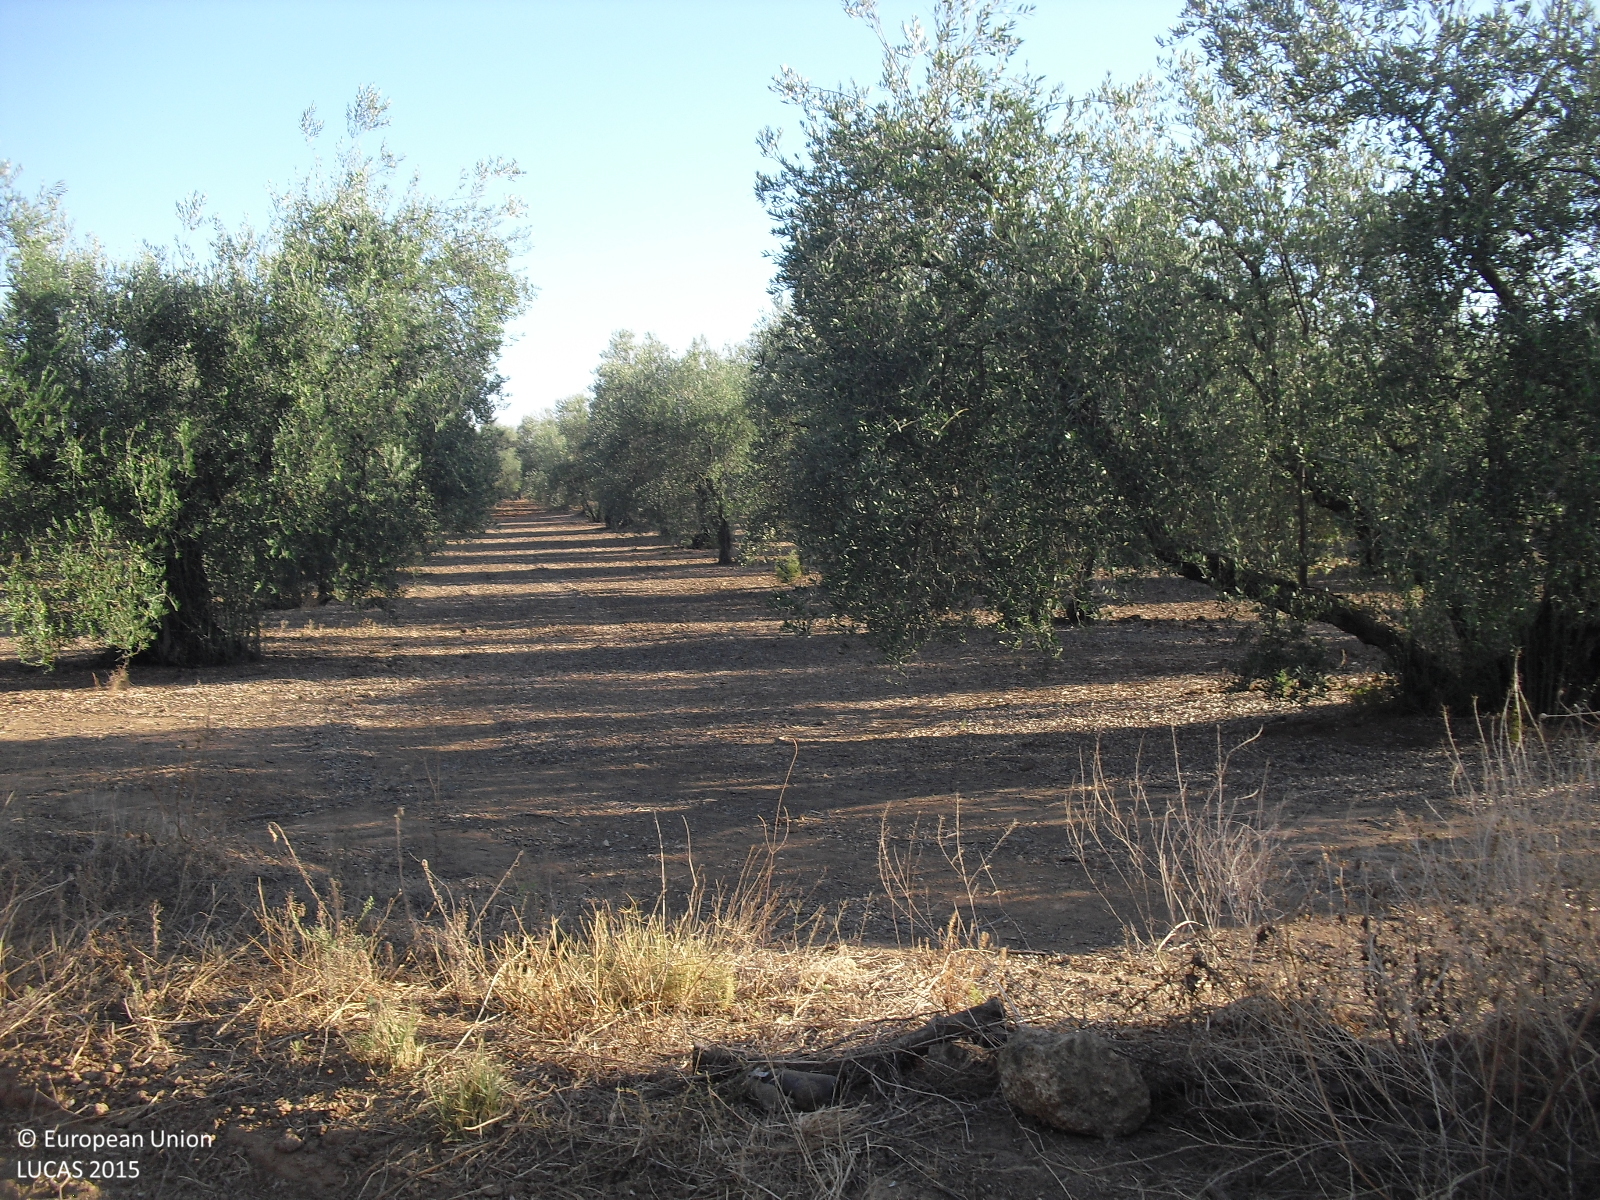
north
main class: Cropland
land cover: Olive groves
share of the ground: 25 - 50 %
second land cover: Other bare soil
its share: > 75 %
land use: Agriculture (excluding fallow land and kitchen gardens)
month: August
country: ES
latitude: 37.2007
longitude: -5.5271
